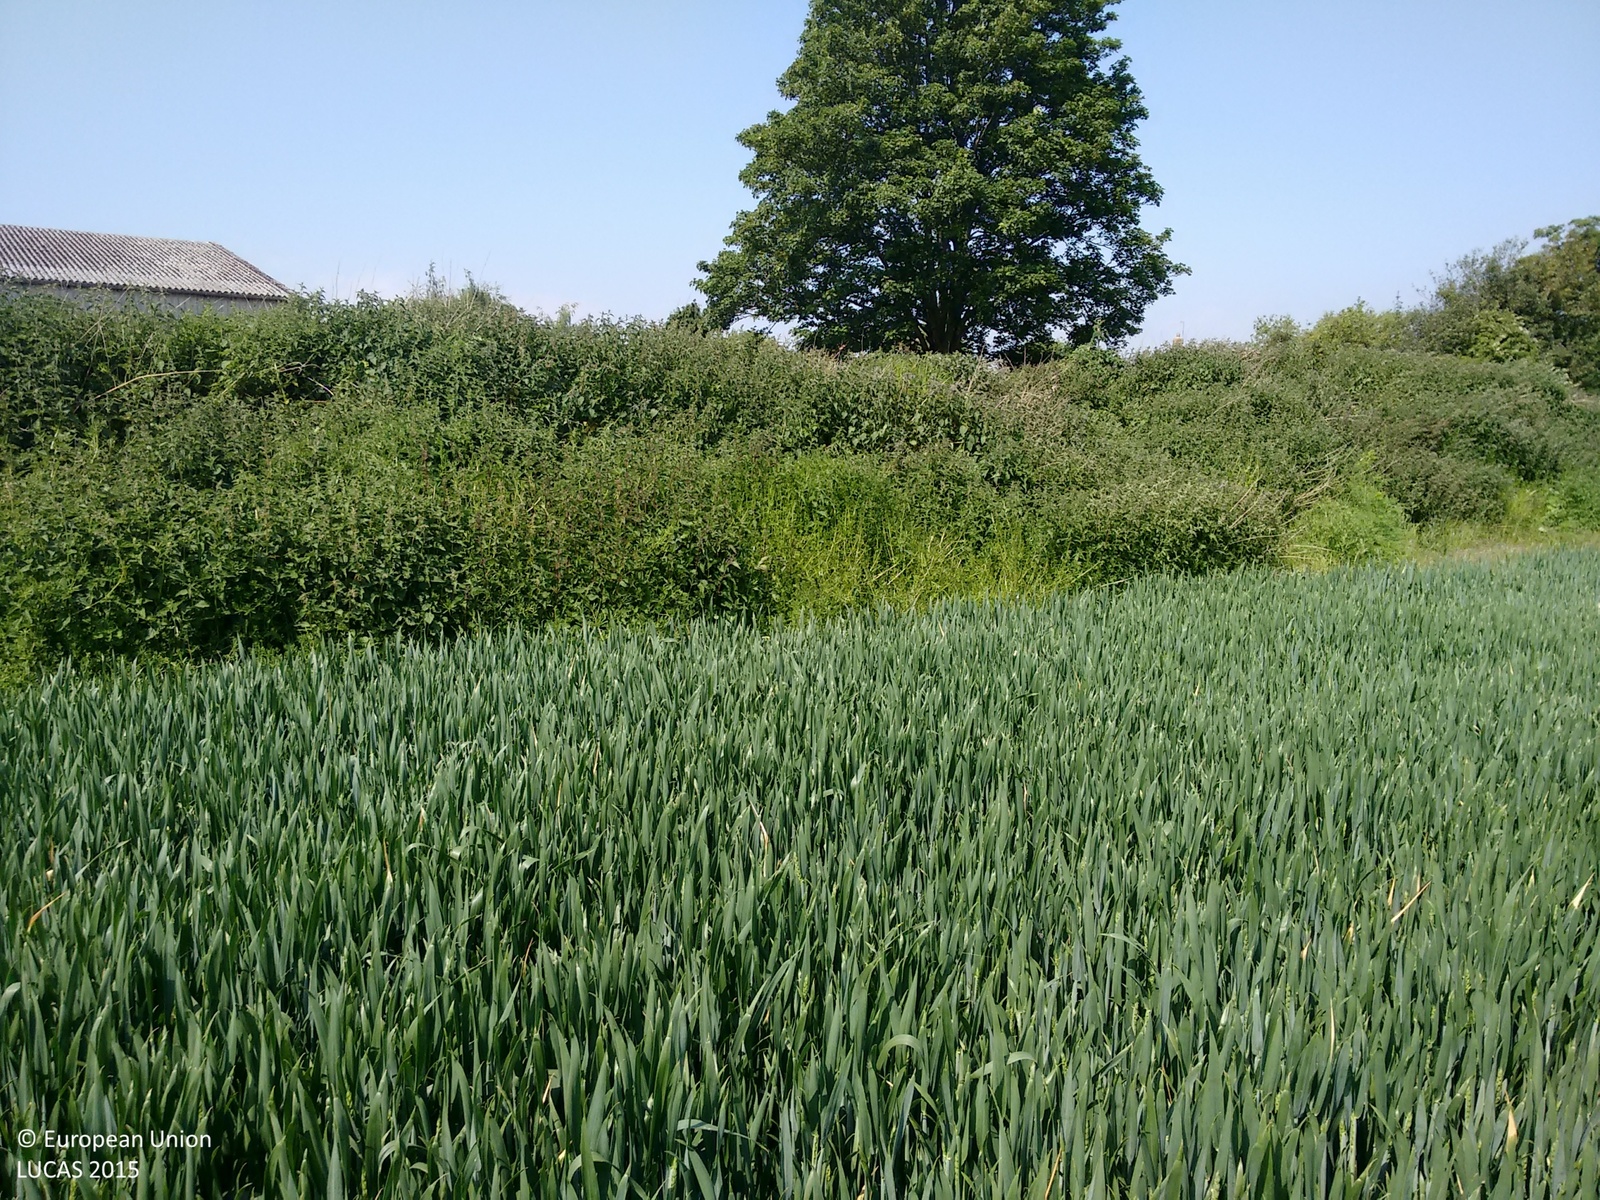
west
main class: Cropland
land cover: Common wheat
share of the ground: > 75 %
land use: Agriculture (excluding fallow land and kitchen gardens)
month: June
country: GB
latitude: 53.9328
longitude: -1.2099
